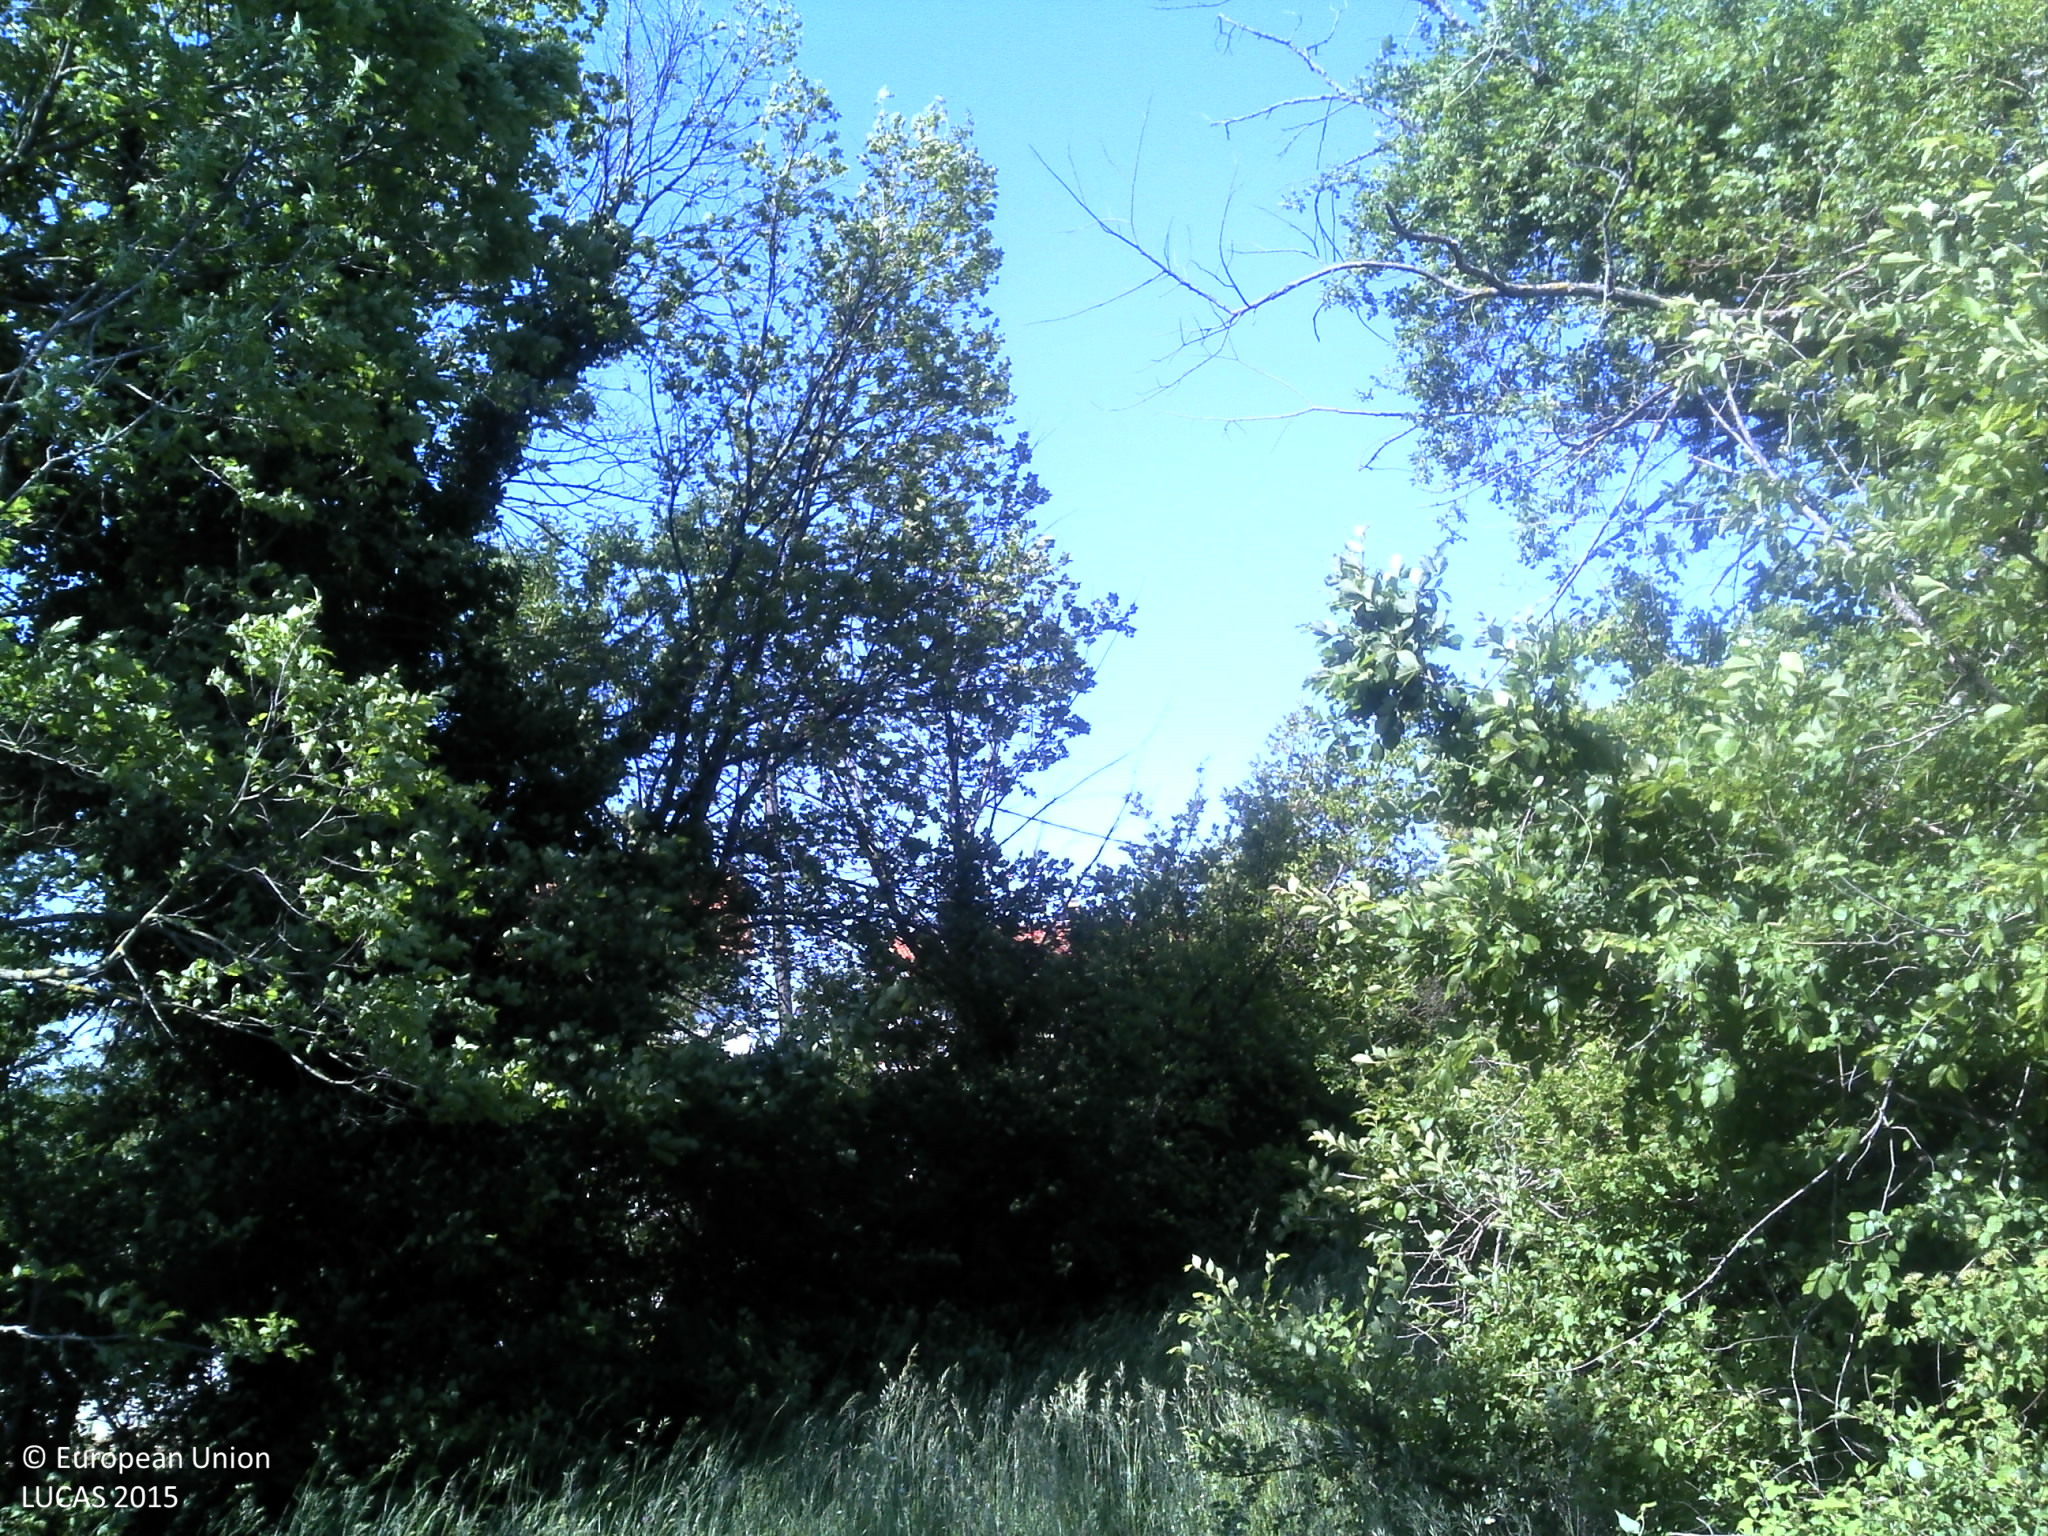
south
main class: Shrubland
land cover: Shrubland with sparse tree cover
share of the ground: 25 - 50 %
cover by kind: herbaceous plants 65 %, shrubs 30 %, broadleaved forest trees 5 %
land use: Semi-natural and natural areas not in use
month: May
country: HR
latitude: 43.8756
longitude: 16.2019
